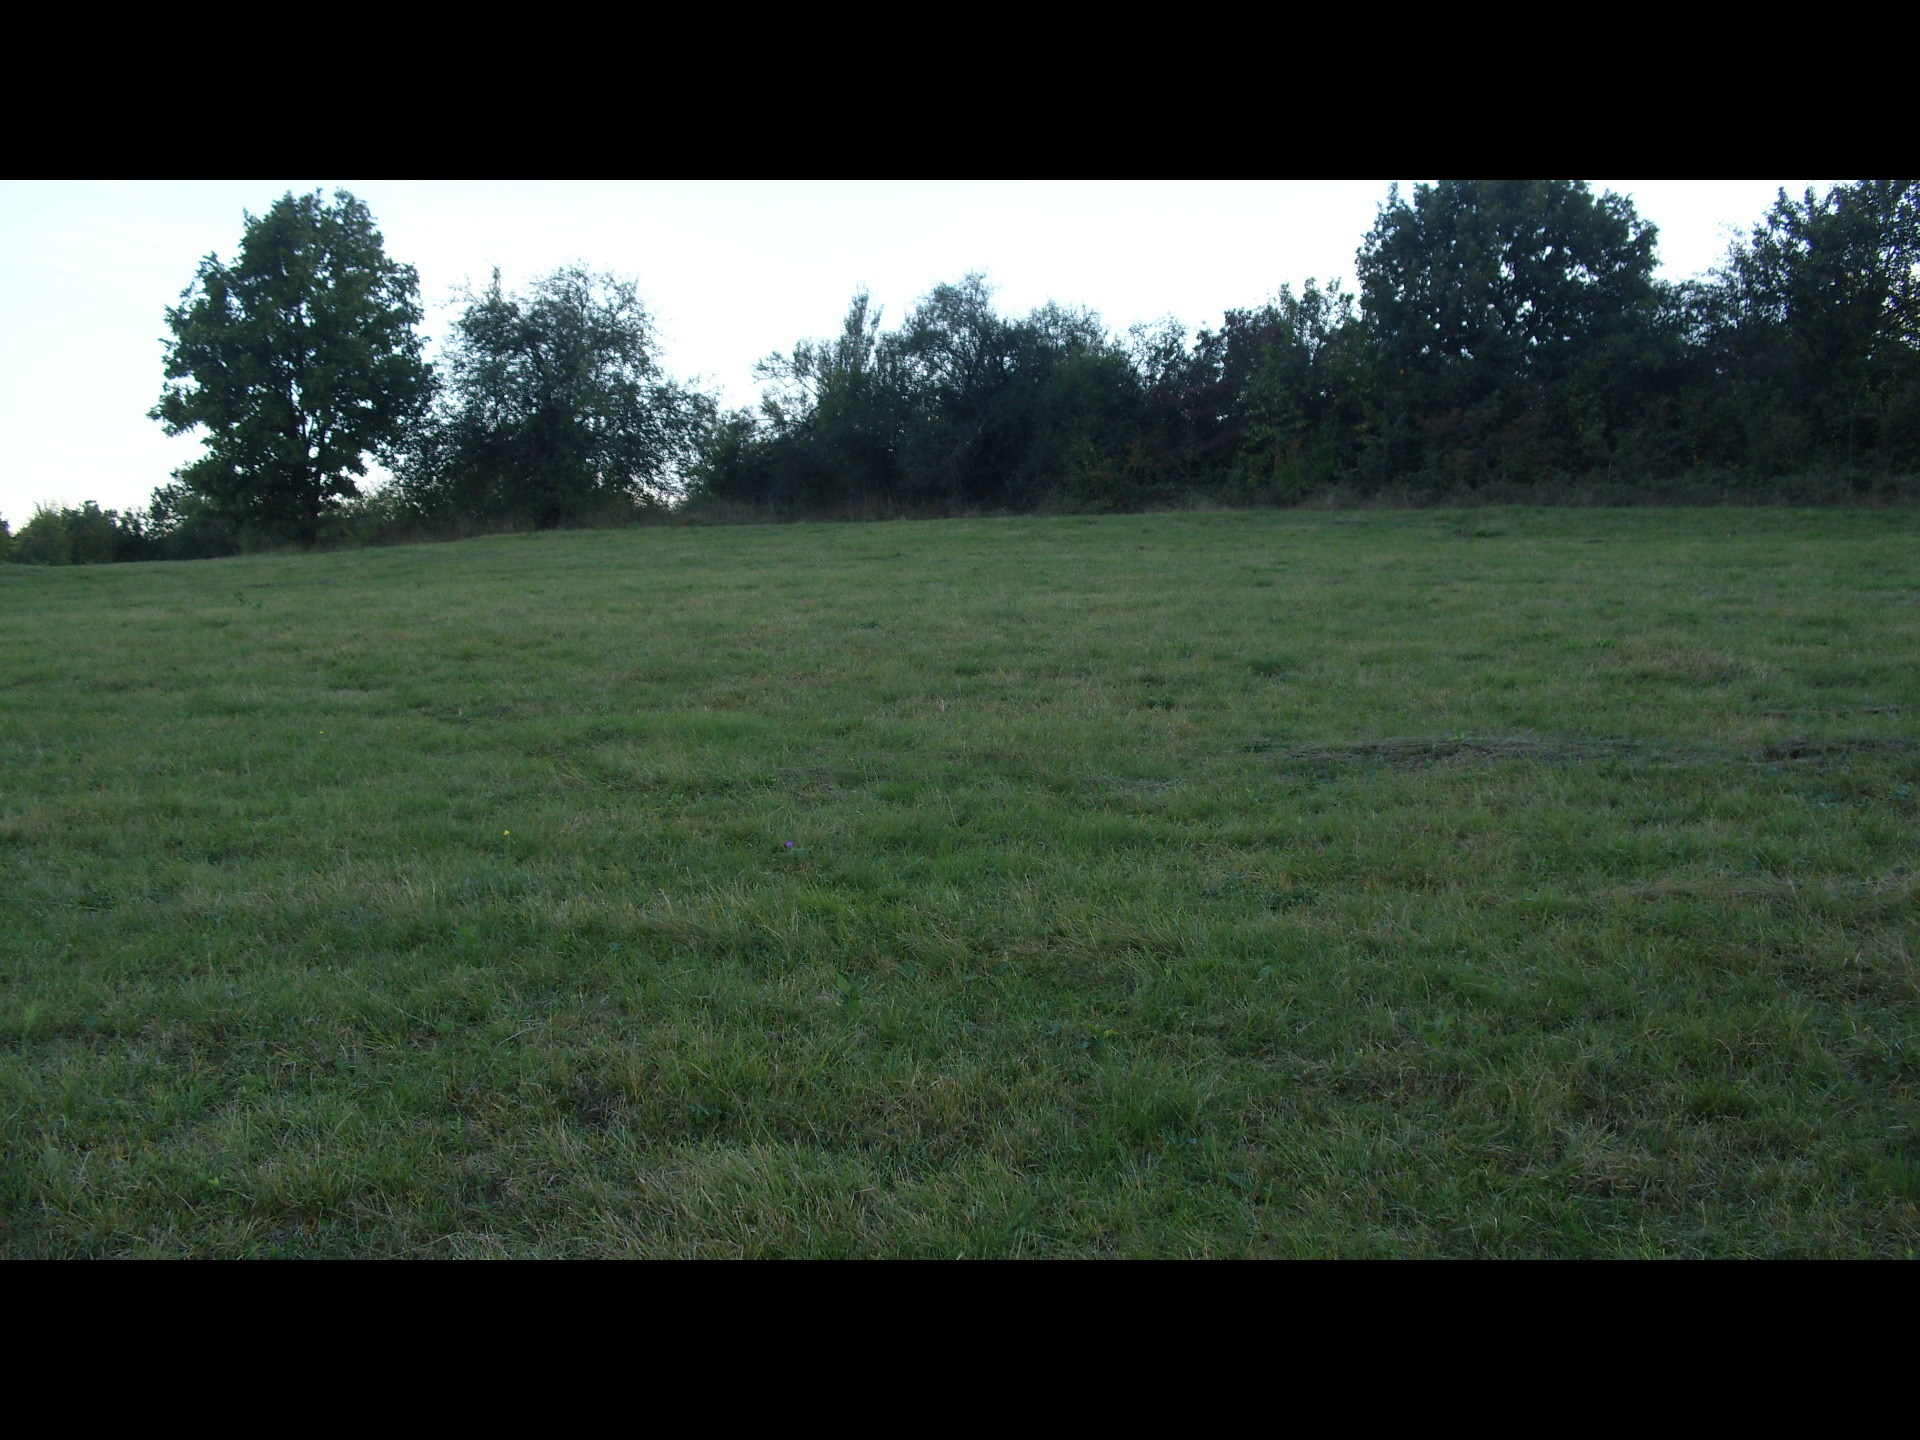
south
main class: Grassland
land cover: Grassland with sparse tree/shrub cover
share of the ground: > 75 %
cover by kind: herbaceous plants 85 %, shrubs 10 %, broadleaved forest trees 5 %
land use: Agriculture (excluding fallow land and kitchen gardens)
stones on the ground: < 10 %
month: October
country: BG
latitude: 43.4203
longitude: 22.9928
